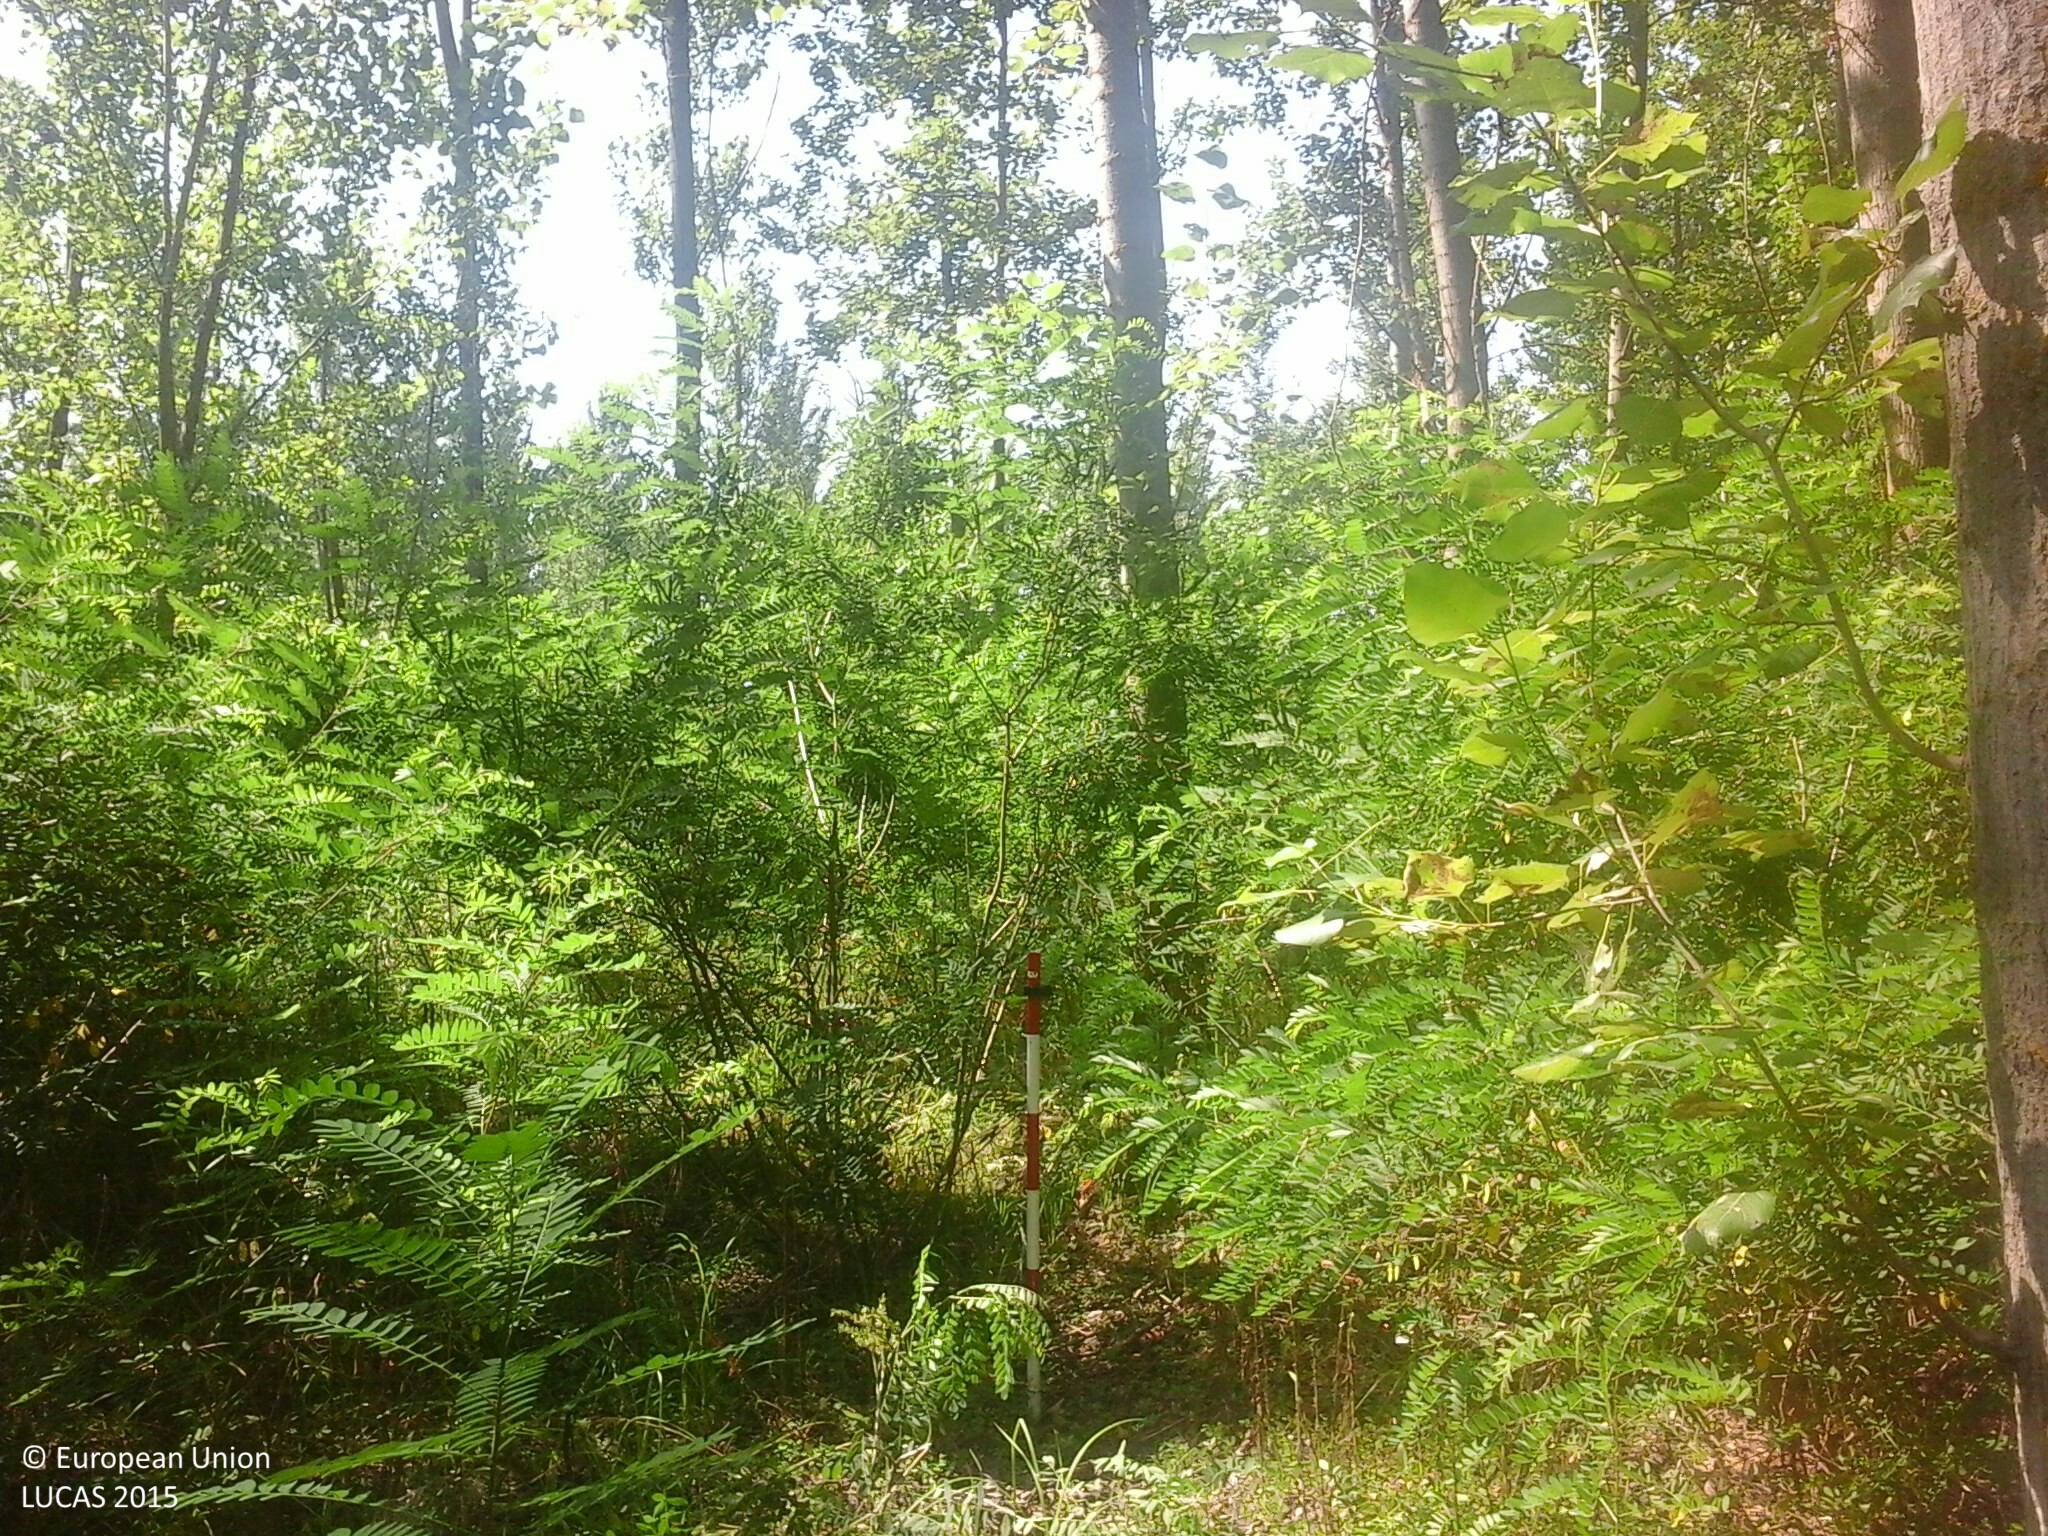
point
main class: Woodland
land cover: Broadleaved woodland
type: acidophilous oak and oak-birch forest
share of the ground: > 75 %
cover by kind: broadleaved forest trees 95 %, herbaceous plants 5 %
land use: Forestry
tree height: > 5 m
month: July
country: HU
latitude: 47.8873
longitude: 22.3741
